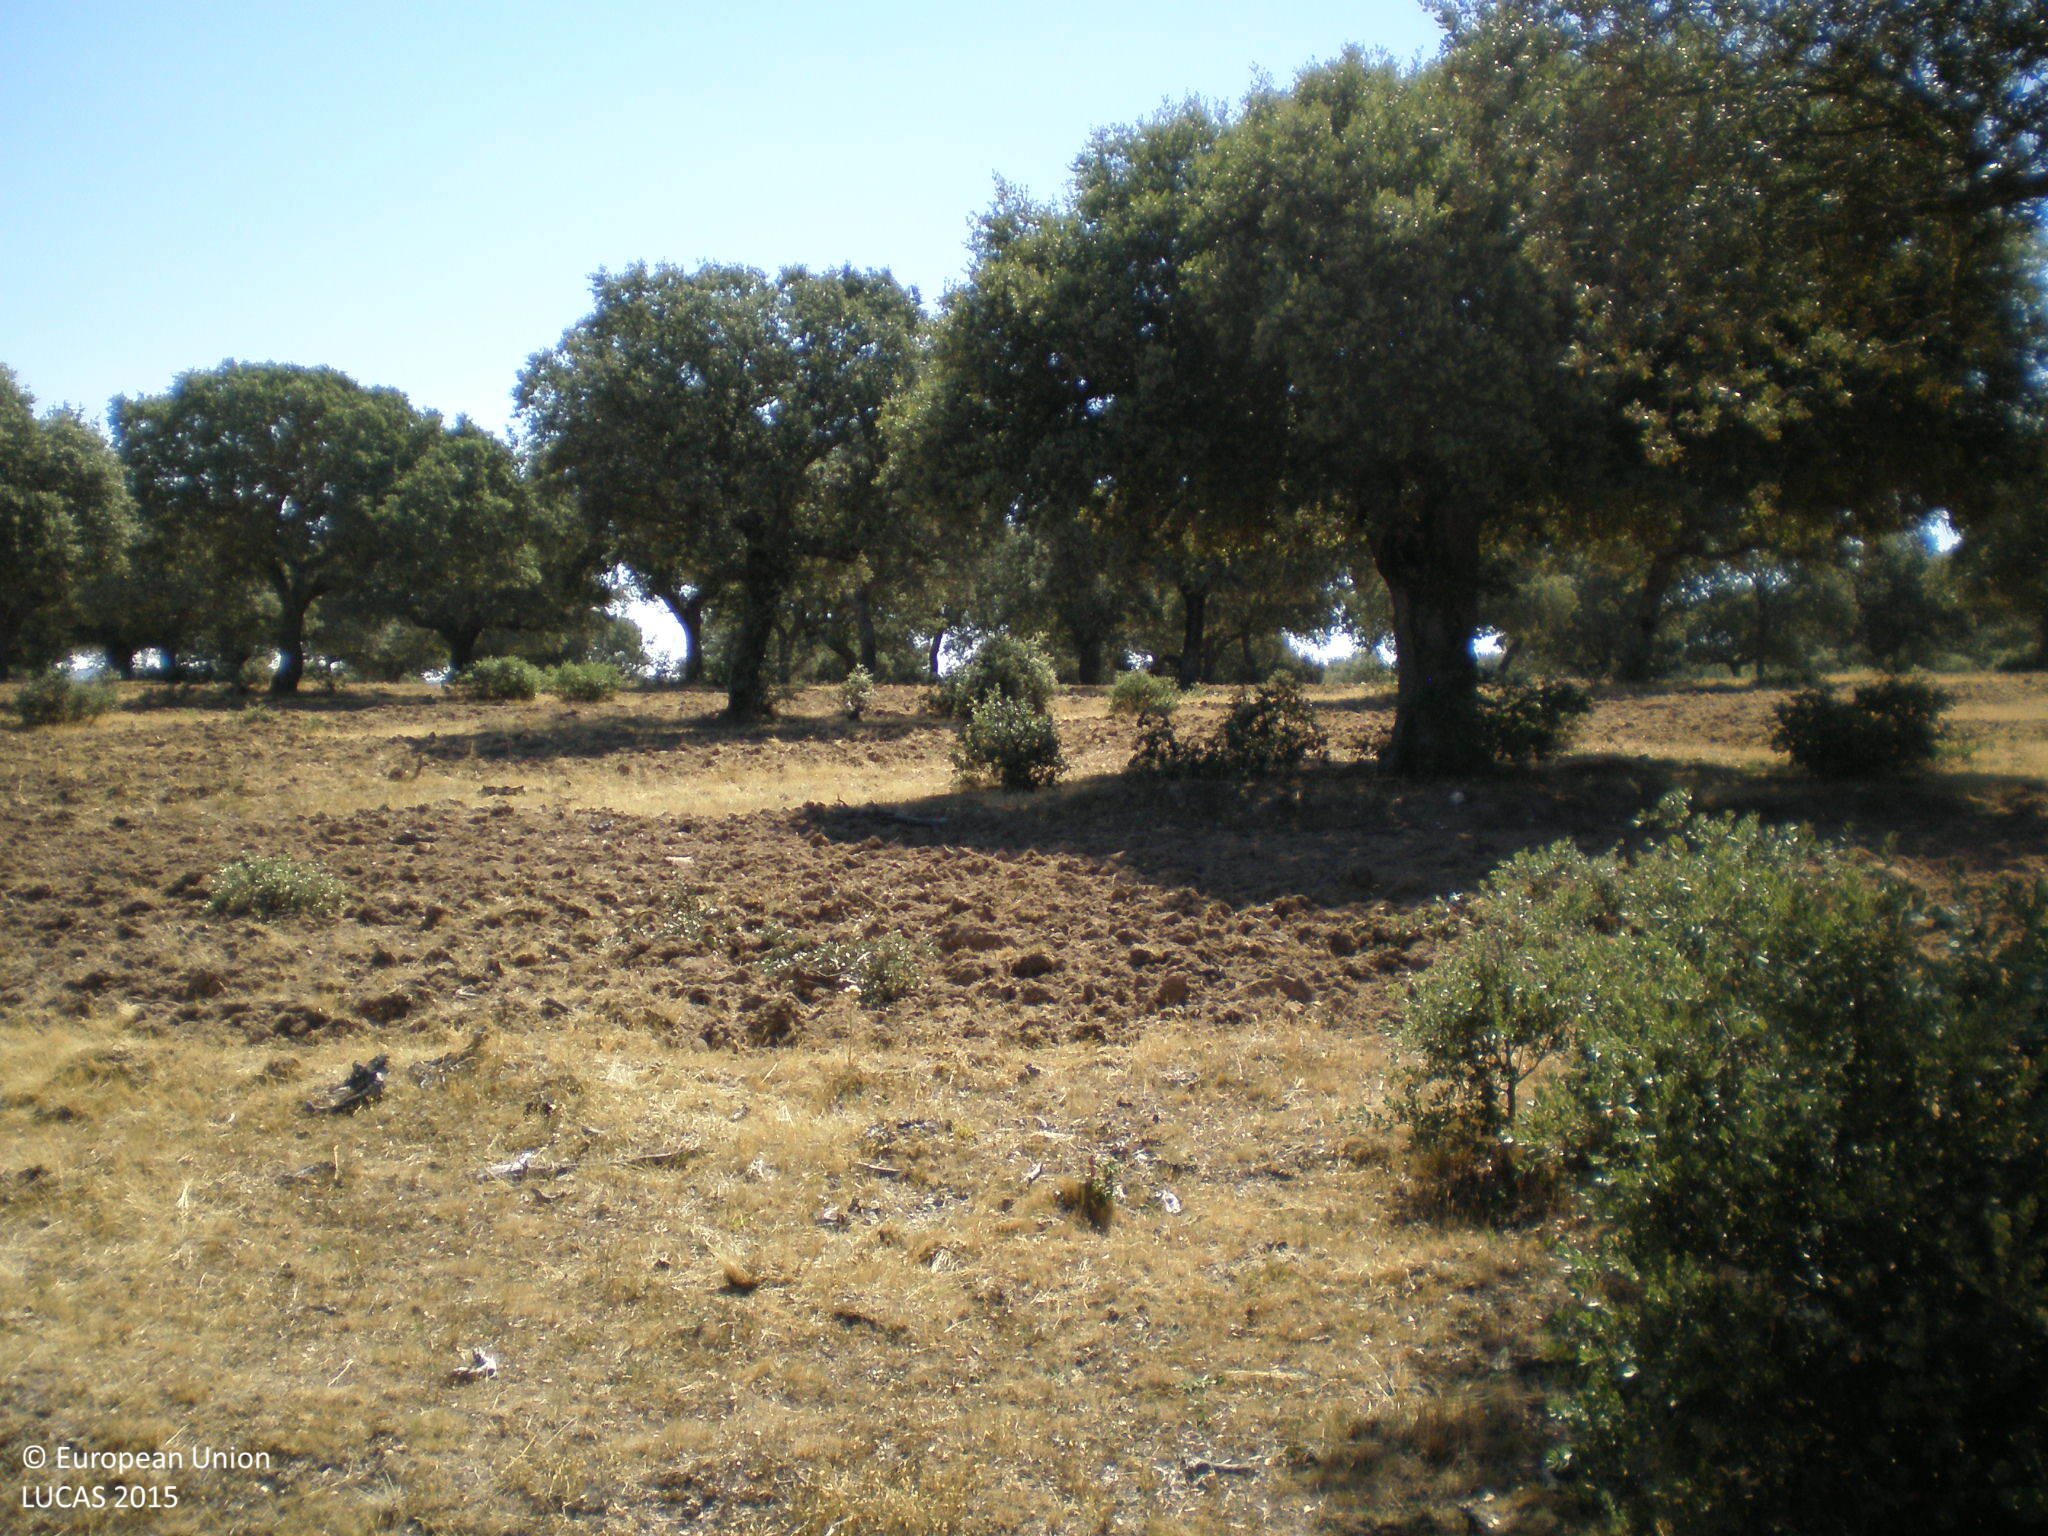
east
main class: Woodland
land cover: Broadleaved woodland
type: broadleaved evergreen forest
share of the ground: 25 - 50 %
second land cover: Grassland without tree/shrub cover
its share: 50 - 75 %
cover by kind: herbaceous plants 65 %, broadleaved forest trees 35 %
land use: Forestry
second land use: Agriculture (excluding fallow land and kitchen gardens)
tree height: > 5 m
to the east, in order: Broadleaved woodland; Grassland without tree/shrub cover; Broadleaved woodland; Fences; Broadleaved woodland
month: June
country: ES
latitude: 40.8200
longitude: -5.6662
